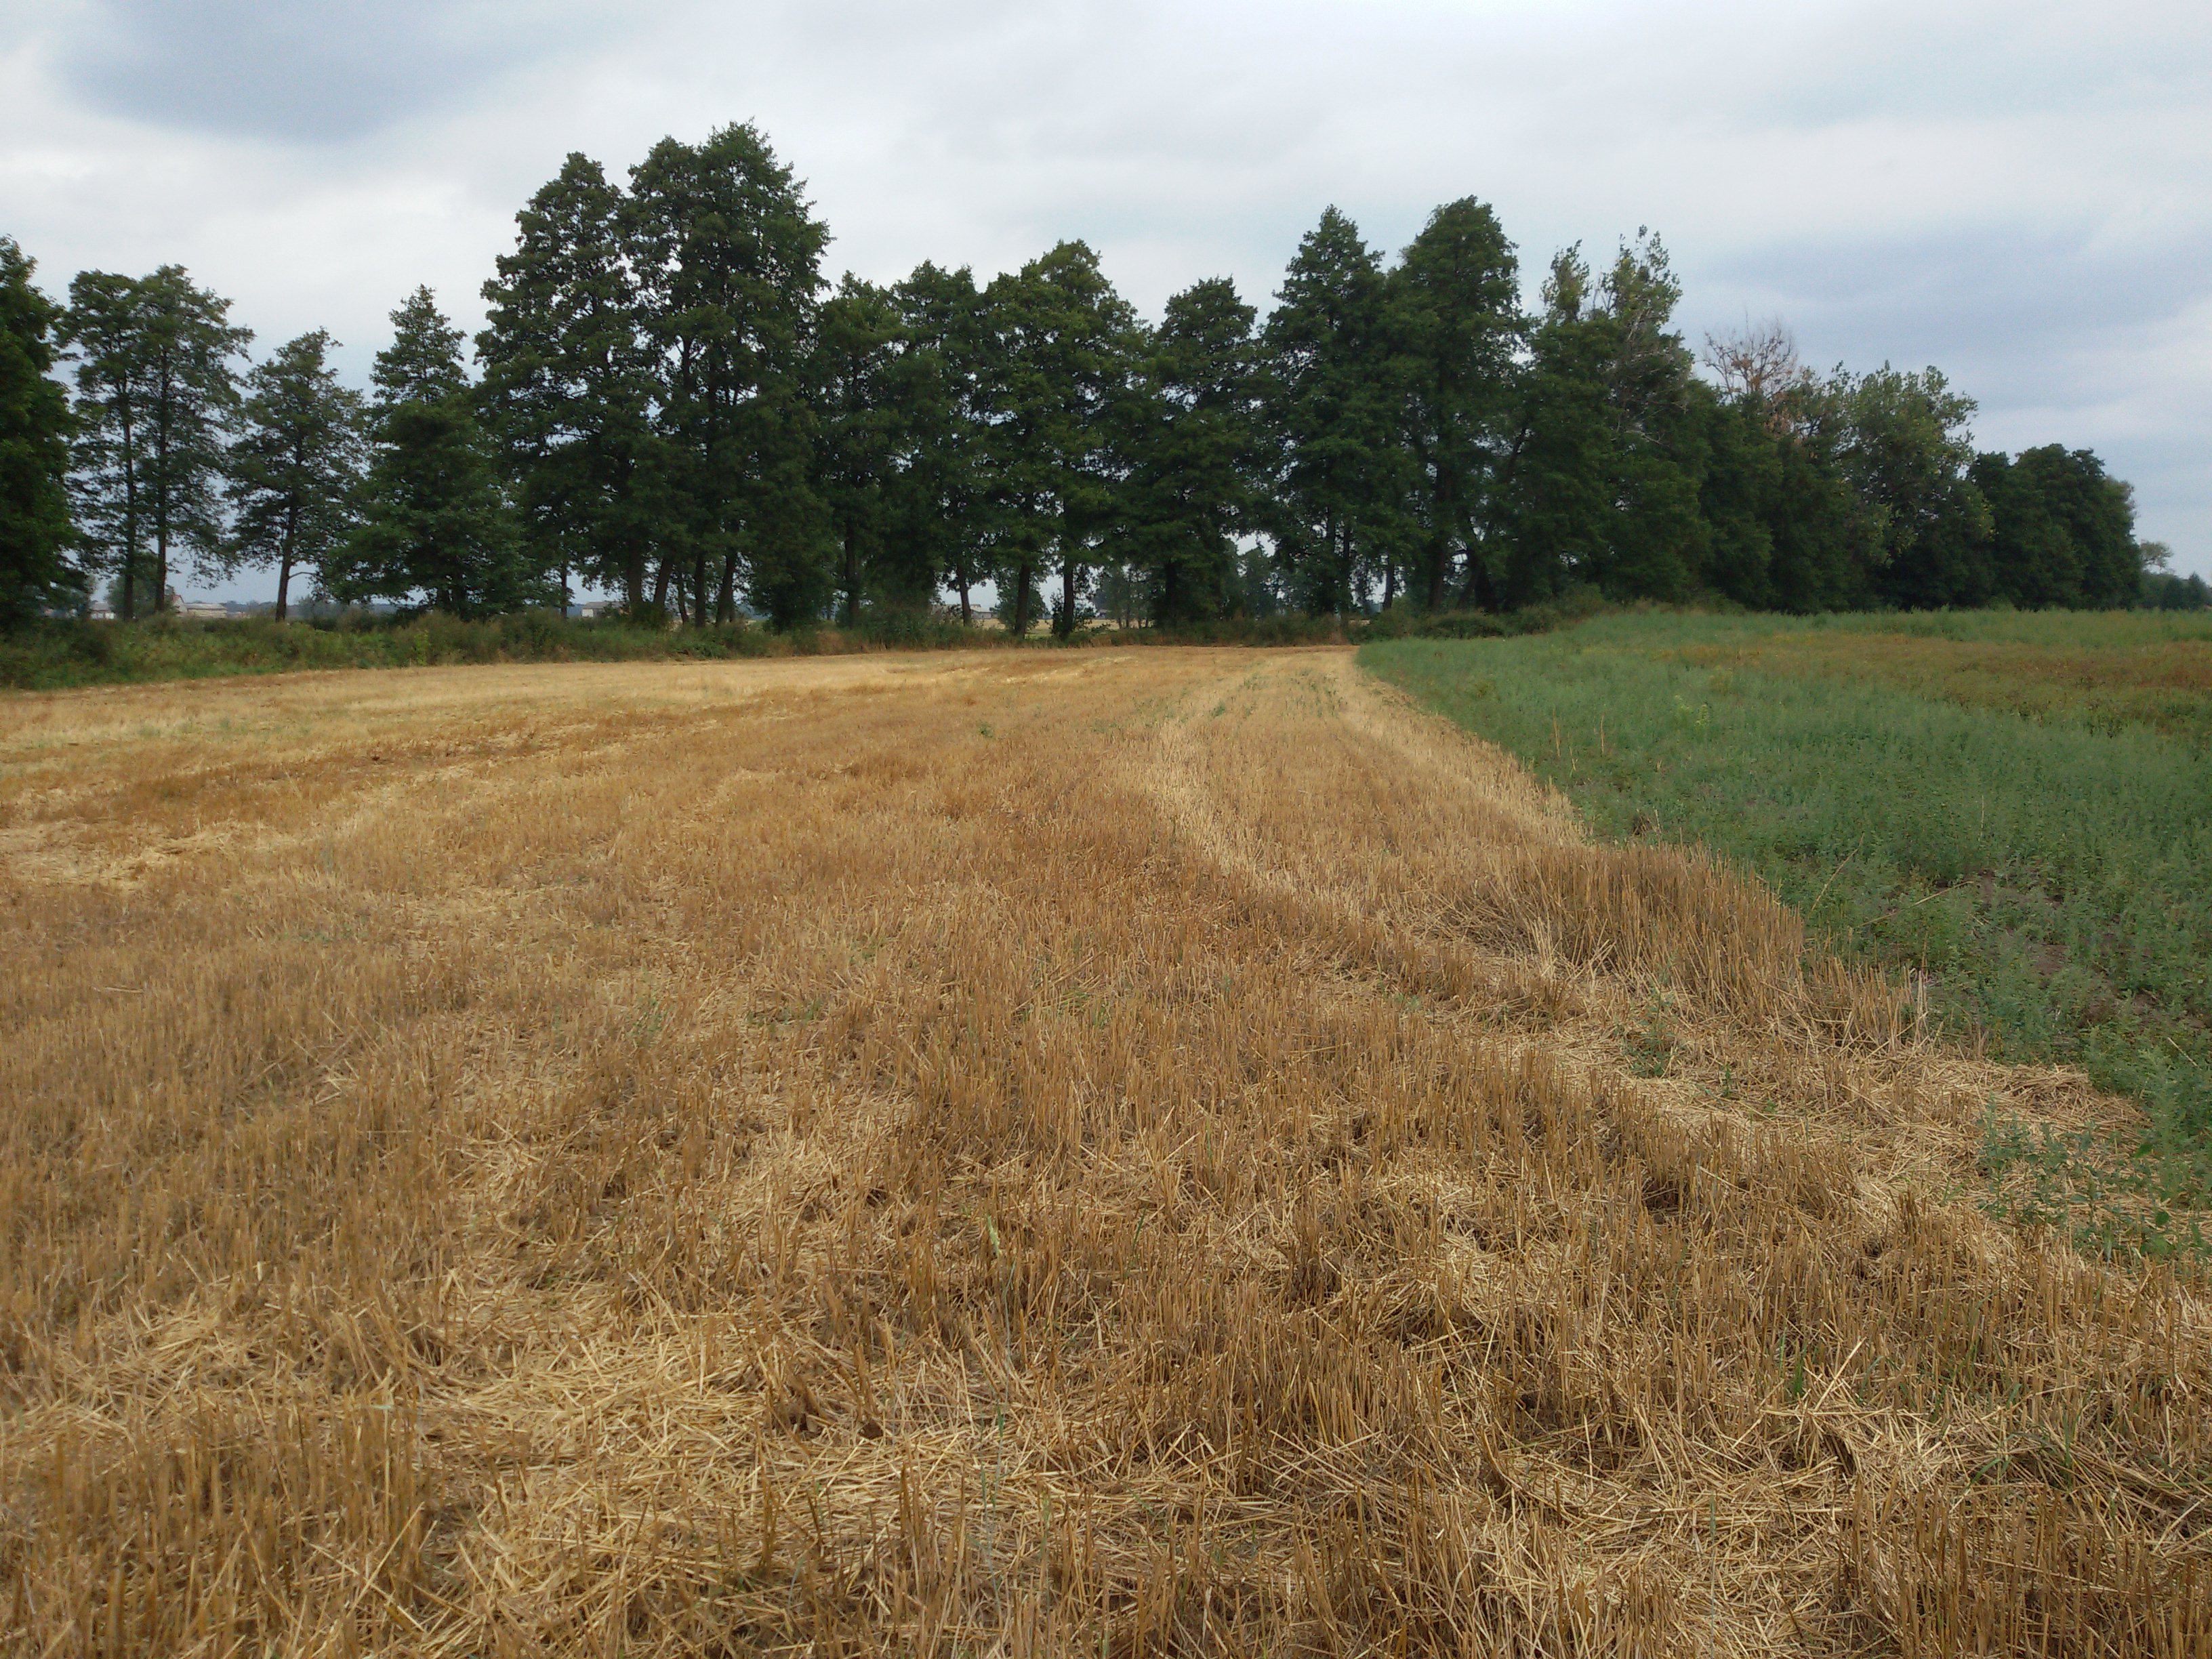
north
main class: Cropland
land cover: Common wheat
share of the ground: > 75 %
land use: Agriculture (excluding fallow land and kitchen gardens)
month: August
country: PL
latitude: 51.7183
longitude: 17.8749
